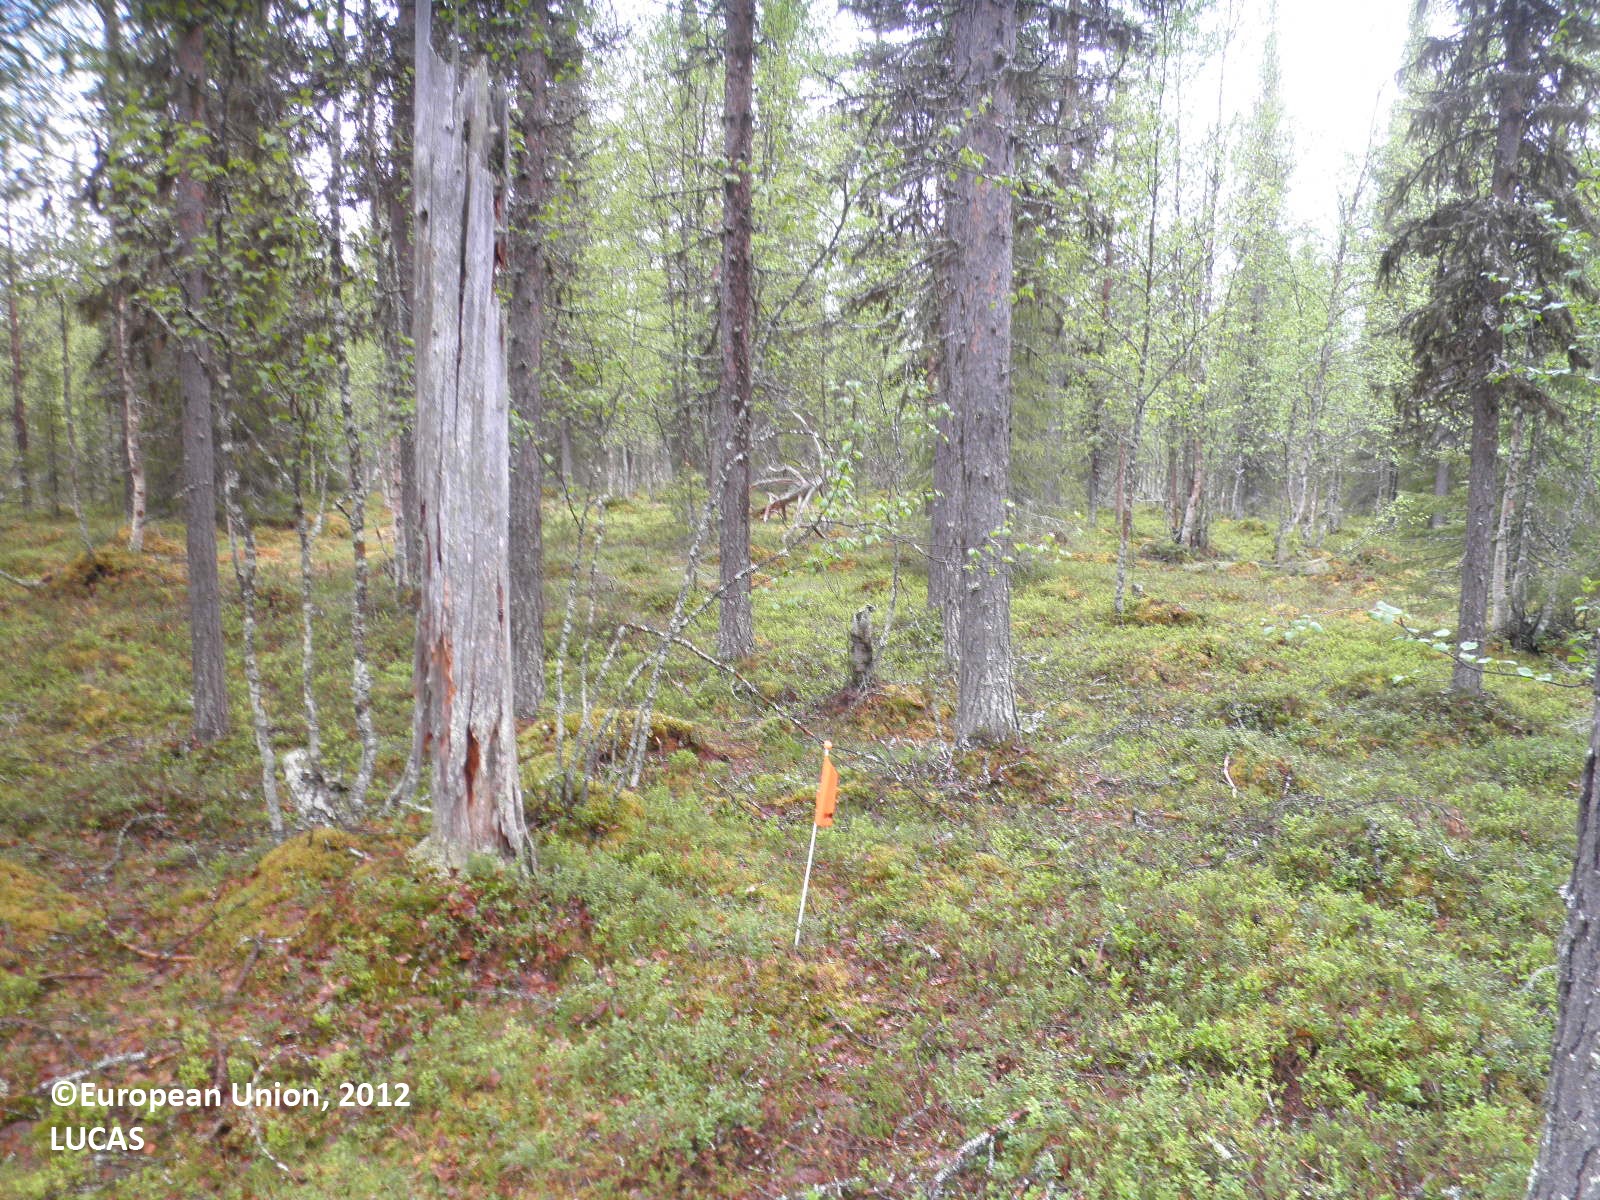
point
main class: Woodland
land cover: Pine dominated mixed woodland
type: boreal forest
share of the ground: > 75 %
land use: Forestry
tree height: > 5 m
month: June
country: FI
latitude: 68.0839
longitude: 25.4274
